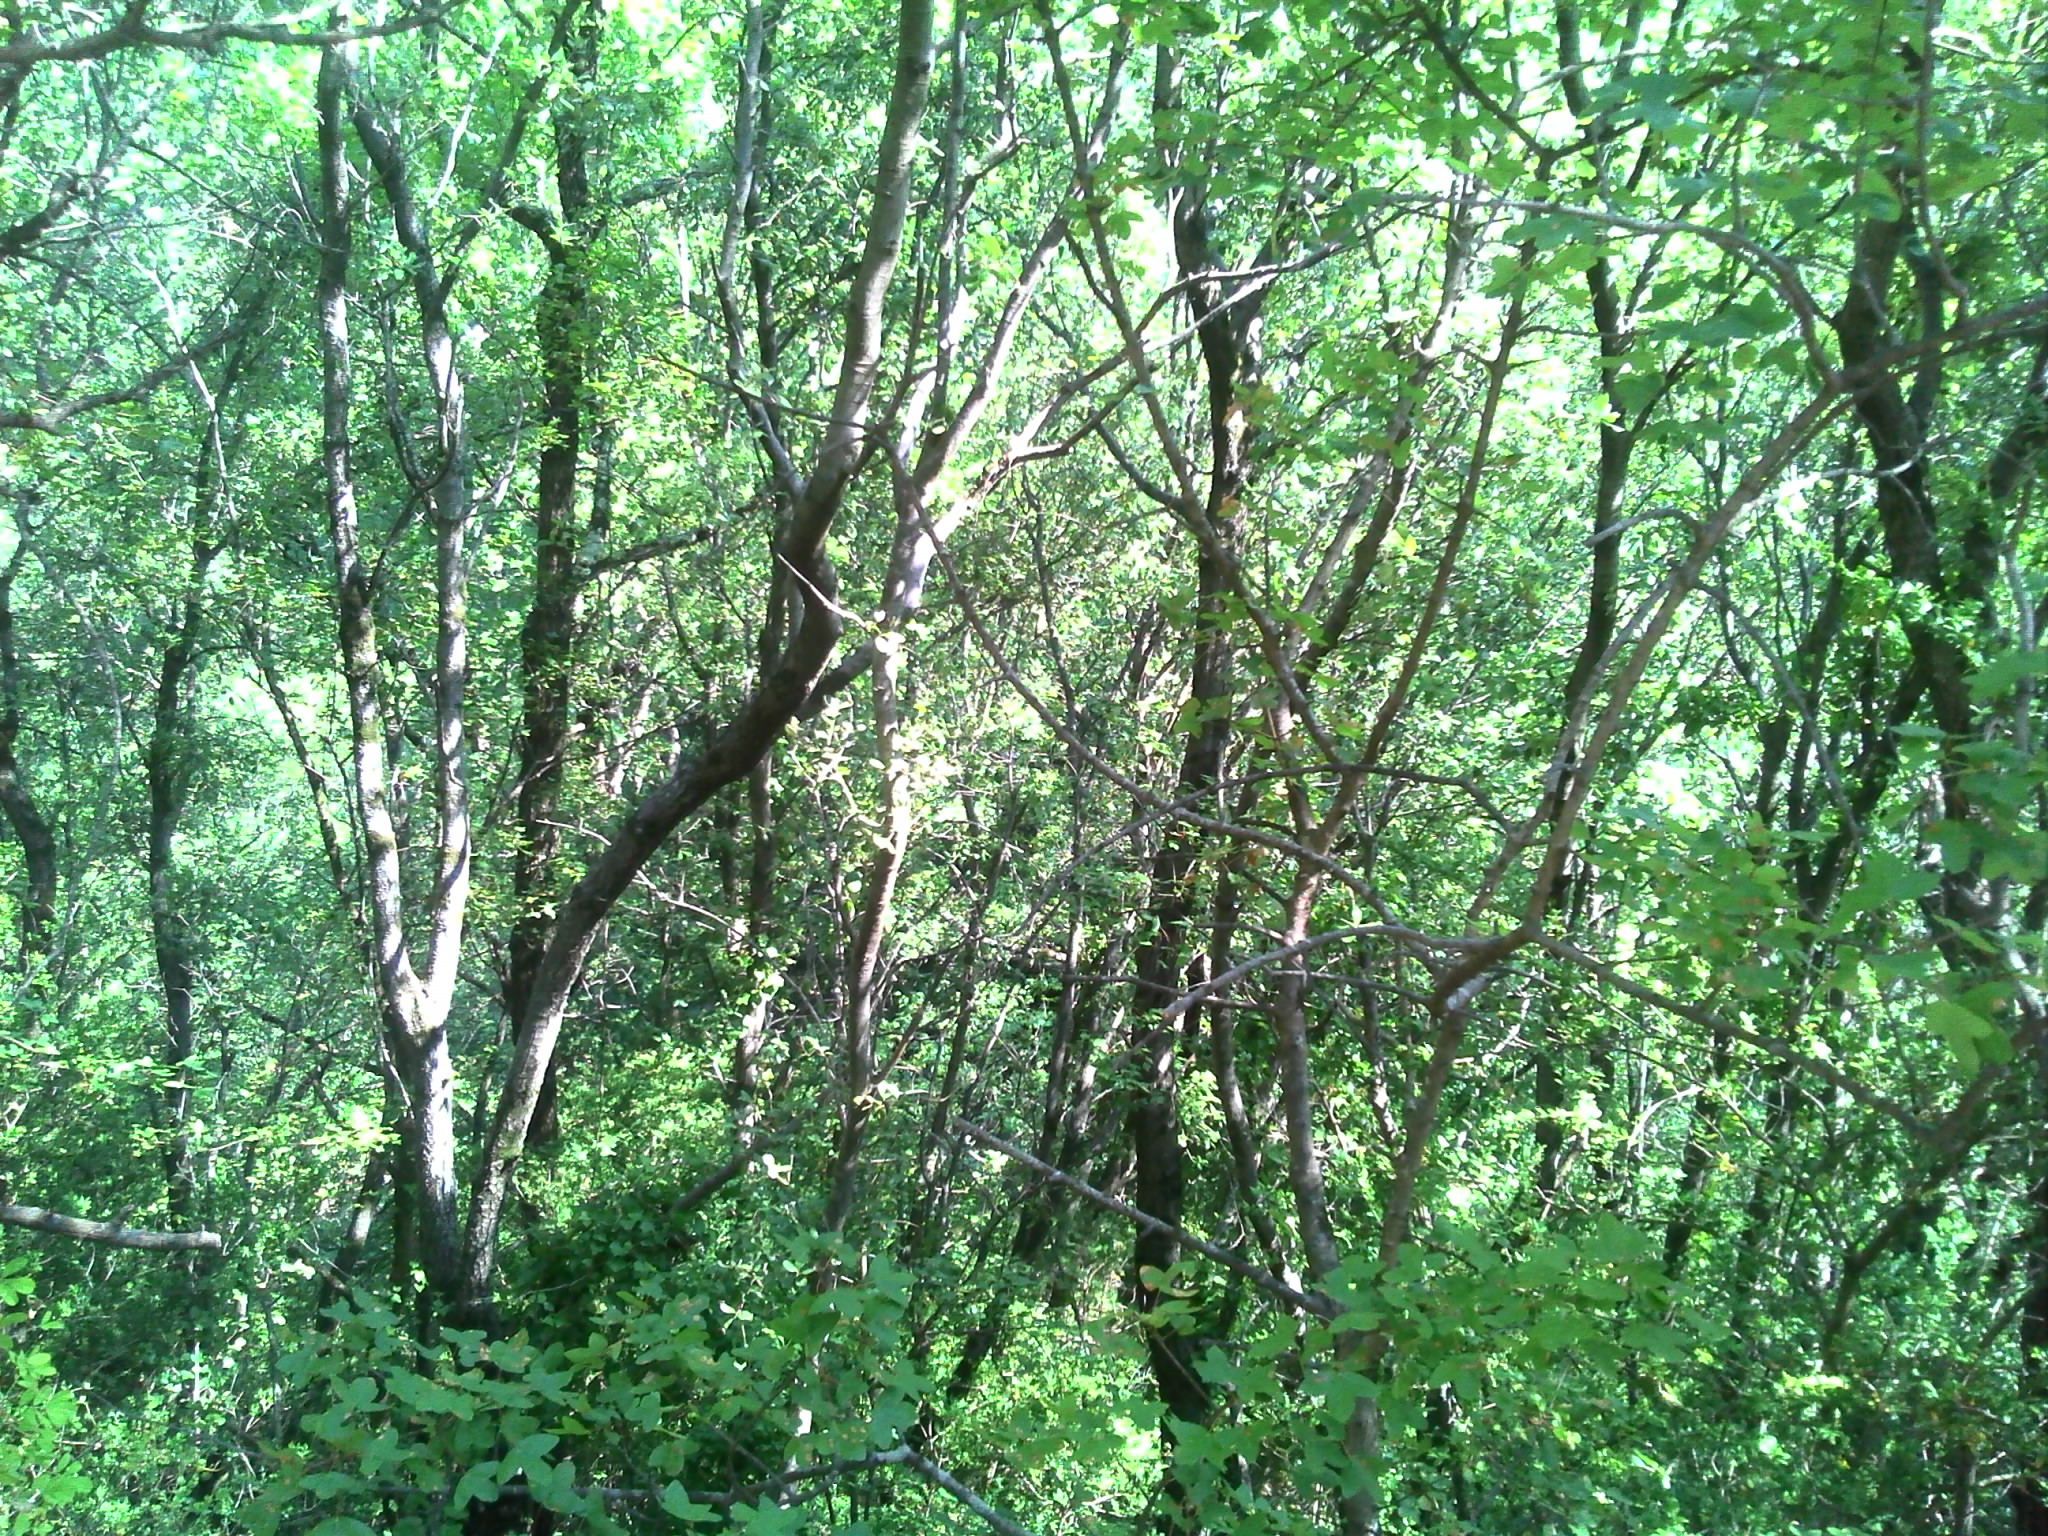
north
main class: Woodland
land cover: Broadleaved woodland
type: broadleaved evergreen forest
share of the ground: > 75 %
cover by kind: broadleaved forest trees 80 %, herbaceous plants 10 %, unconsolidated bare surface 10 %
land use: Forestry
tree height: > 5 m
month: October
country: FR
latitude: 44.0072
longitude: 3.5840
